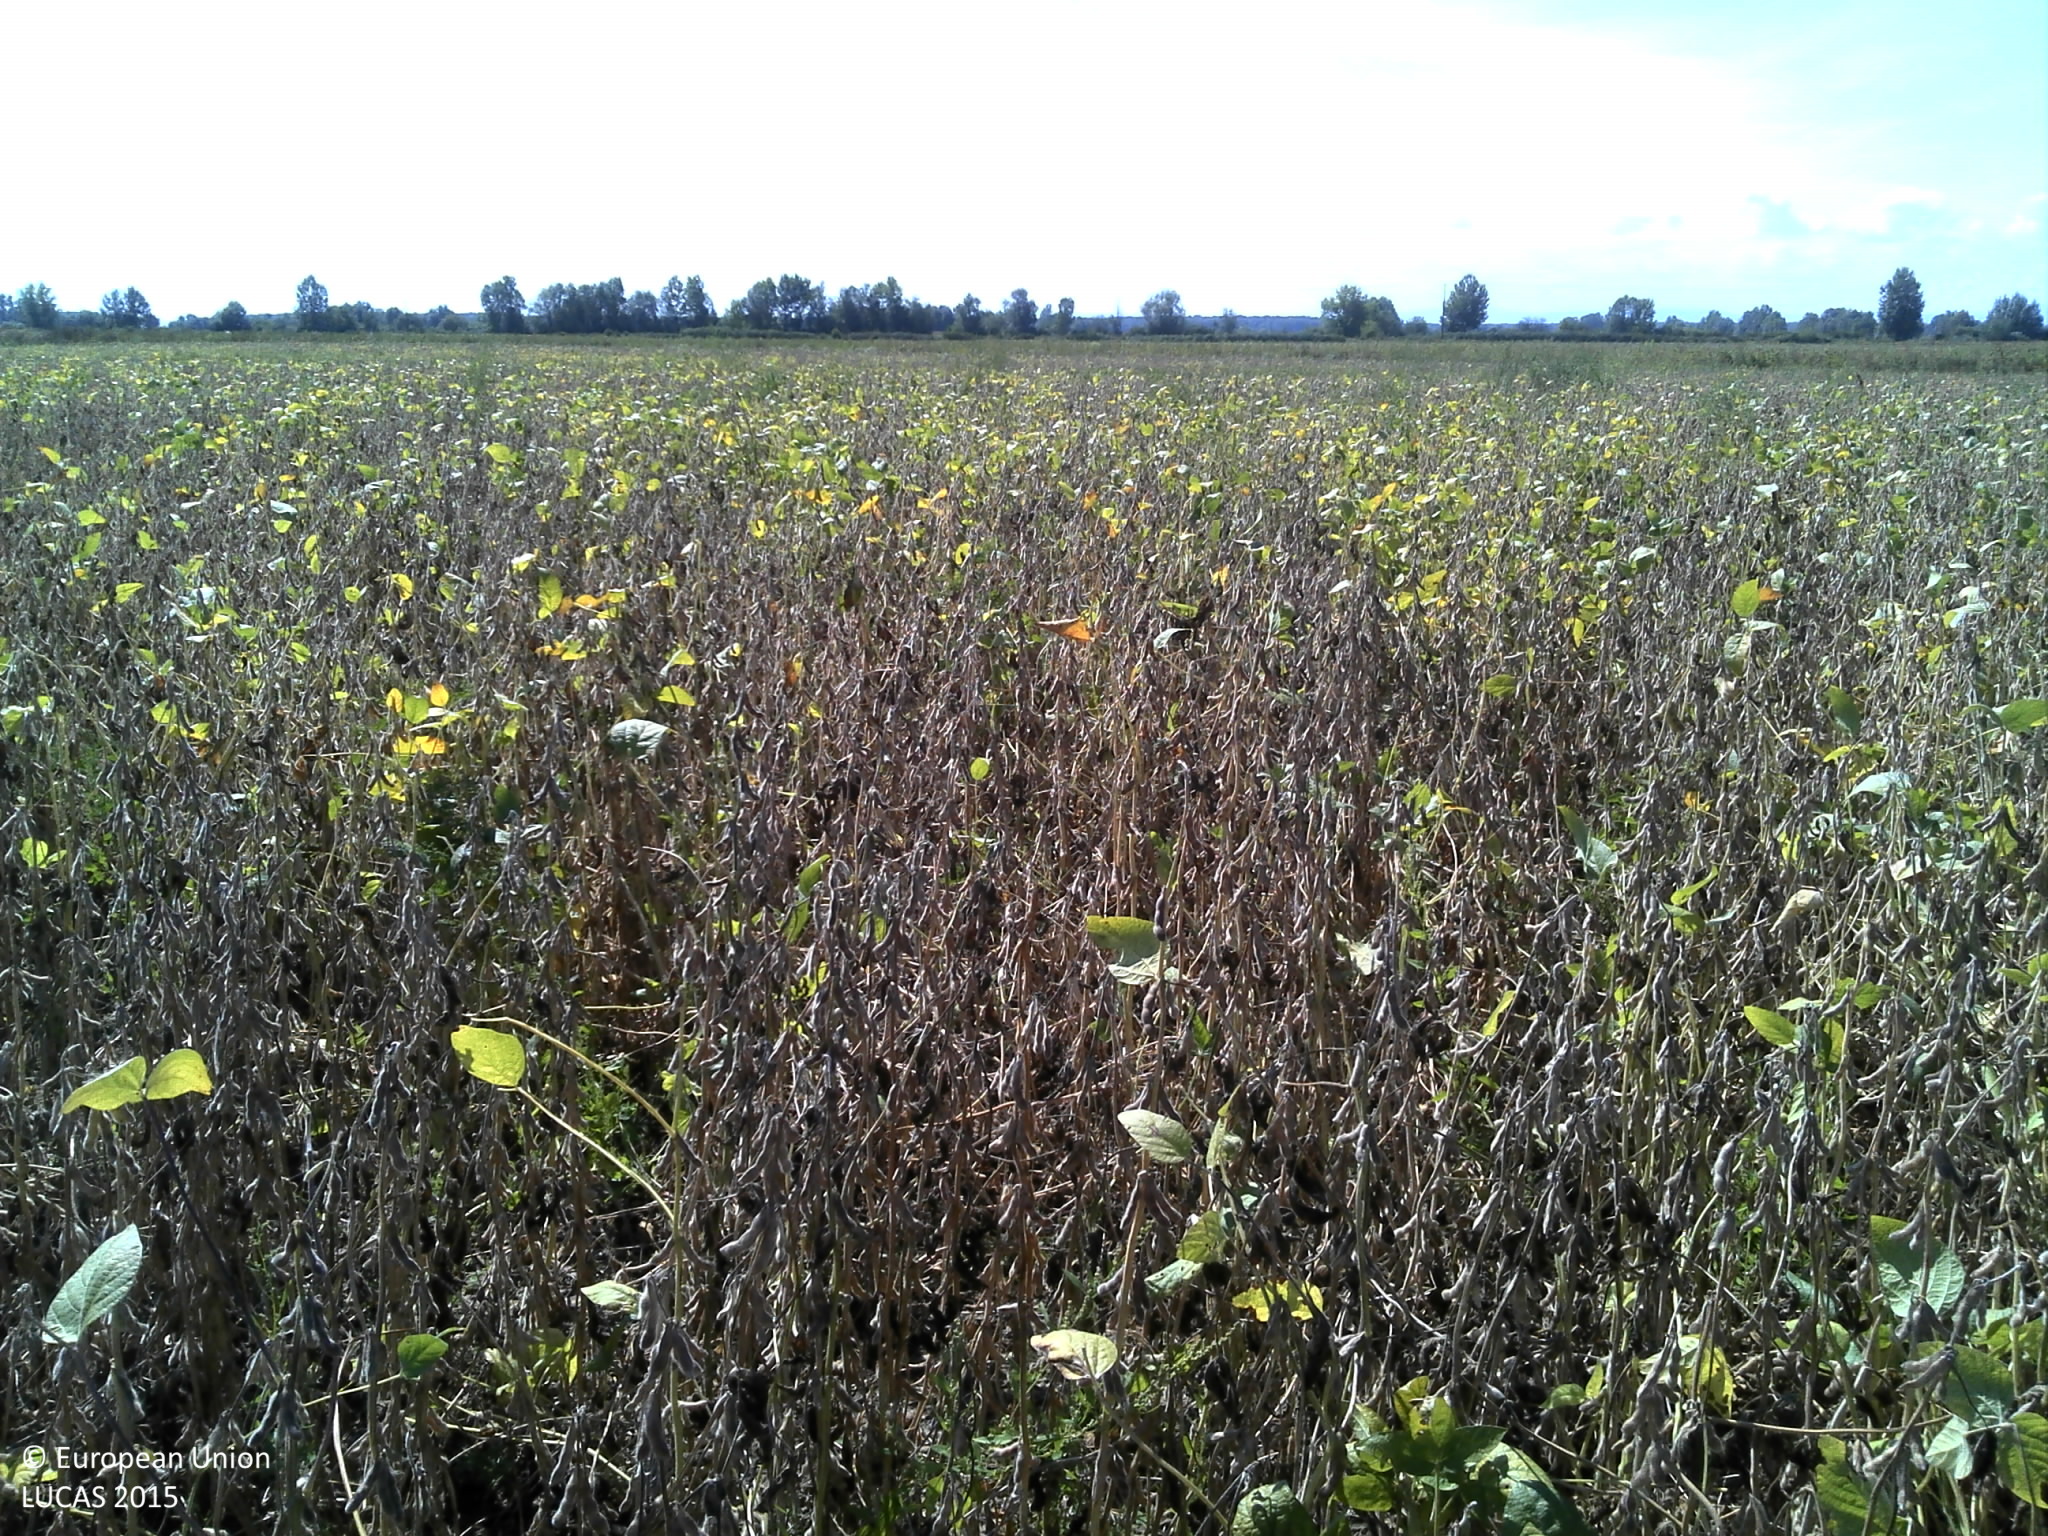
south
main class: Cropland
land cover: Soya
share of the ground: > 75 %
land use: Agriculture (excluding fallow land and kitchen gardens)
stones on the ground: < 10 %
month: September
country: HR
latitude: 44.9367
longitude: 19.0166
